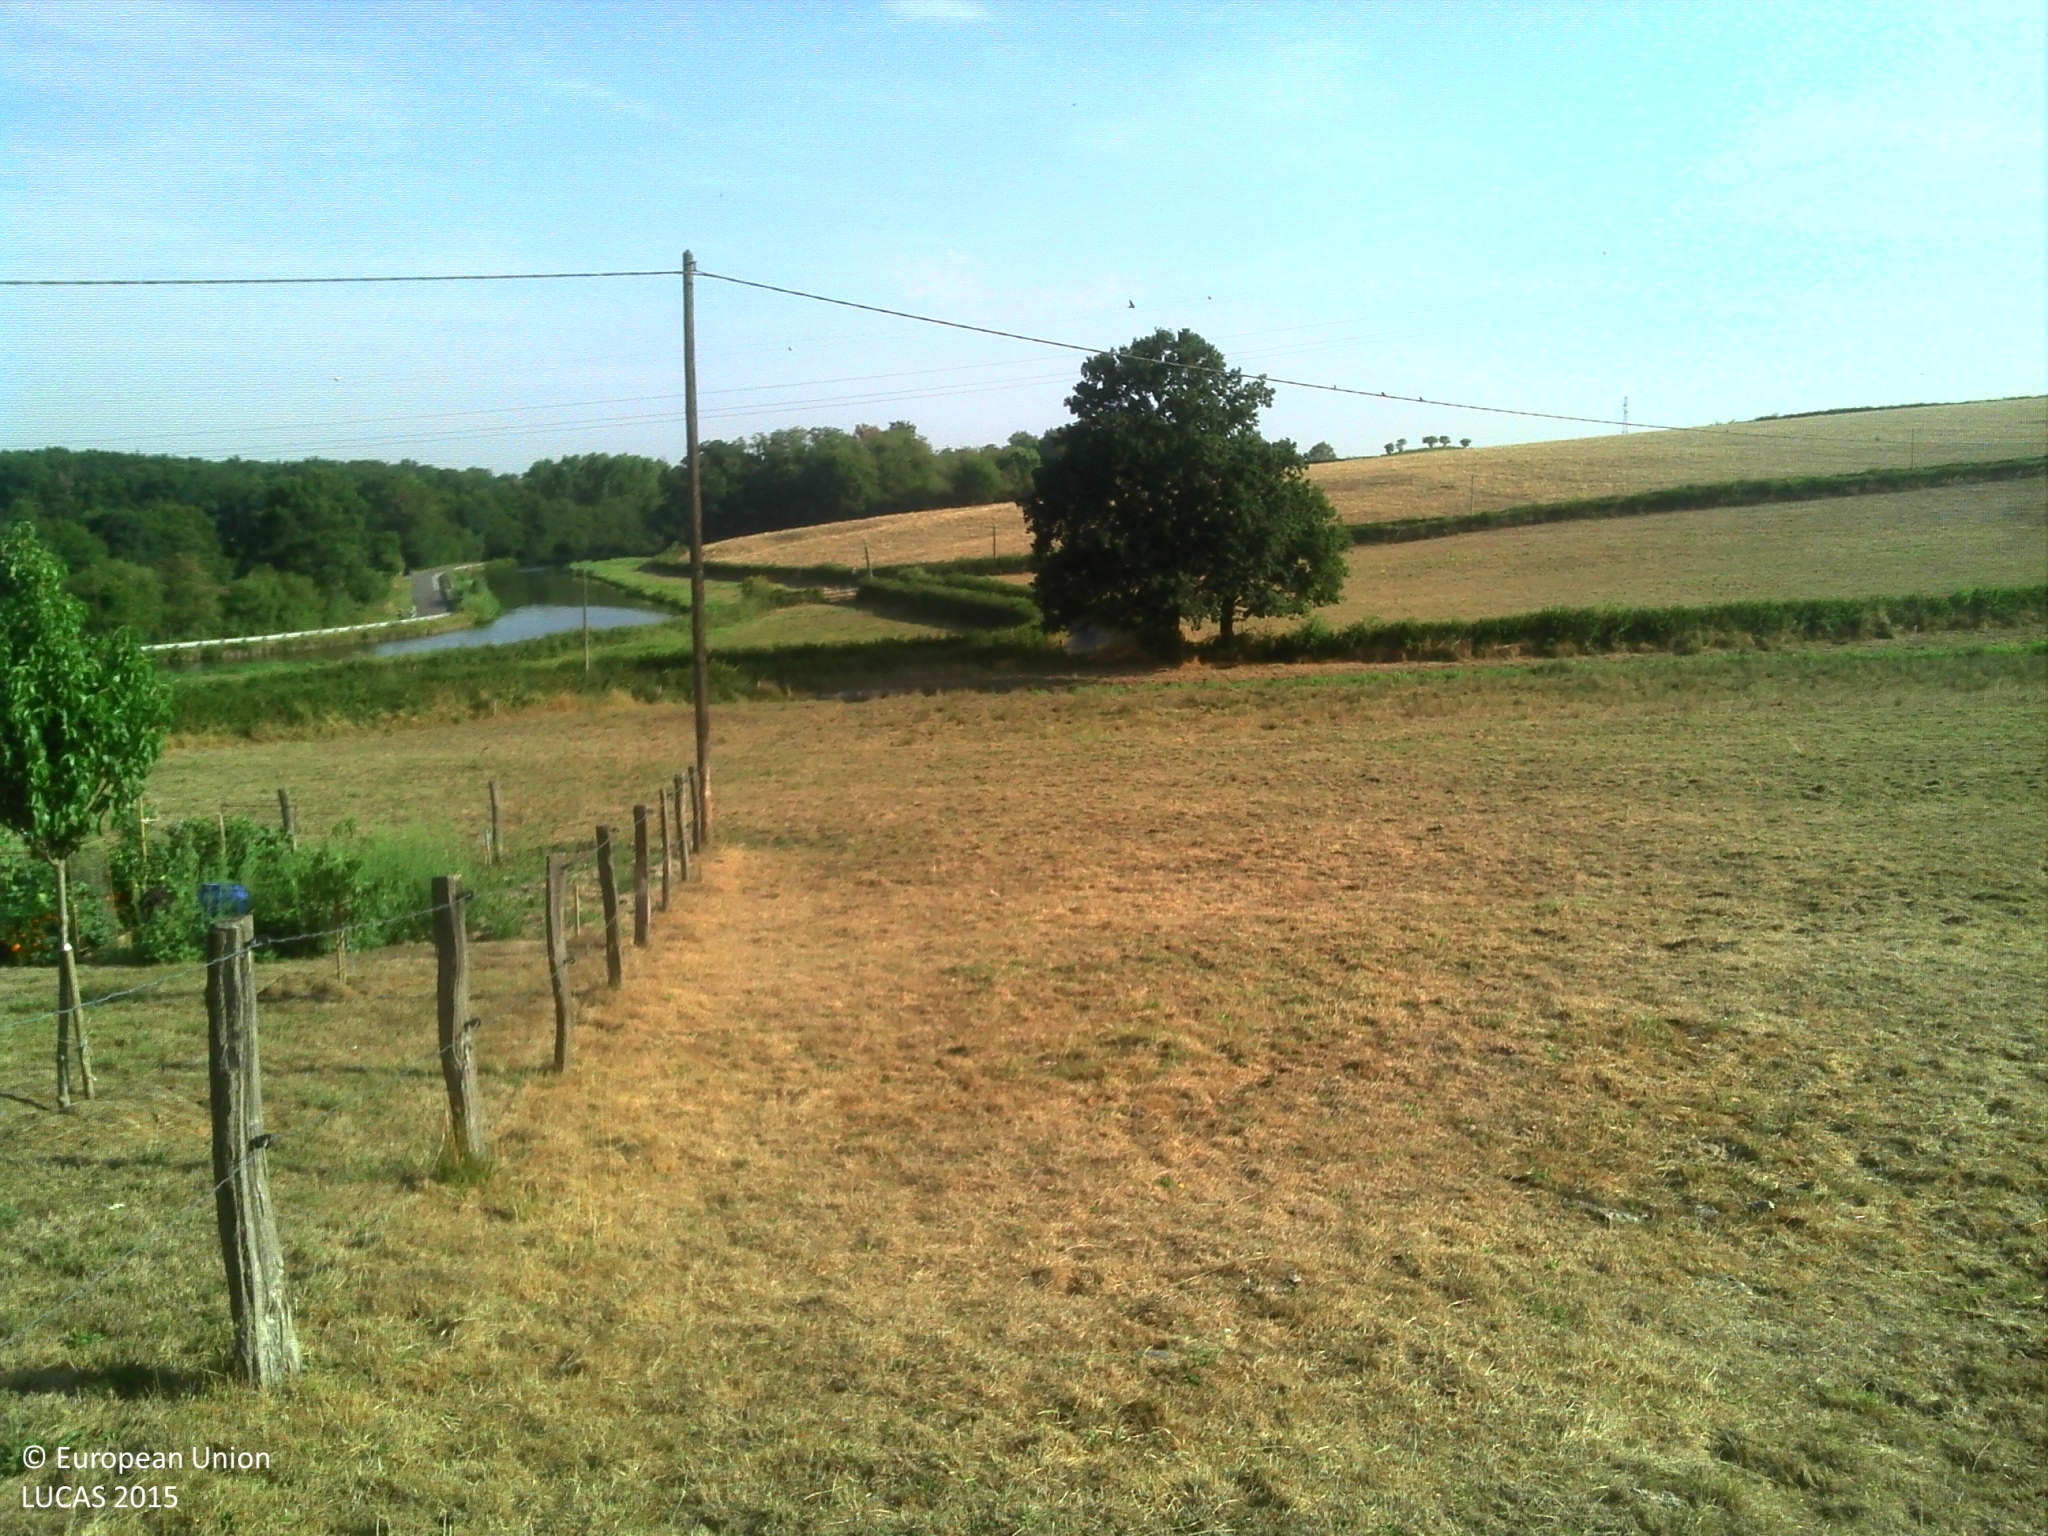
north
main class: Grassland
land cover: Grassland without tree/shrub cover
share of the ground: > 75 %
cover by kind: herbaceous plants 100 %
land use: Agriculture (excluding fallow land and kitchen gardens)
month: August
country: FR
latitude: 46.7121
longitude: 4.4412
